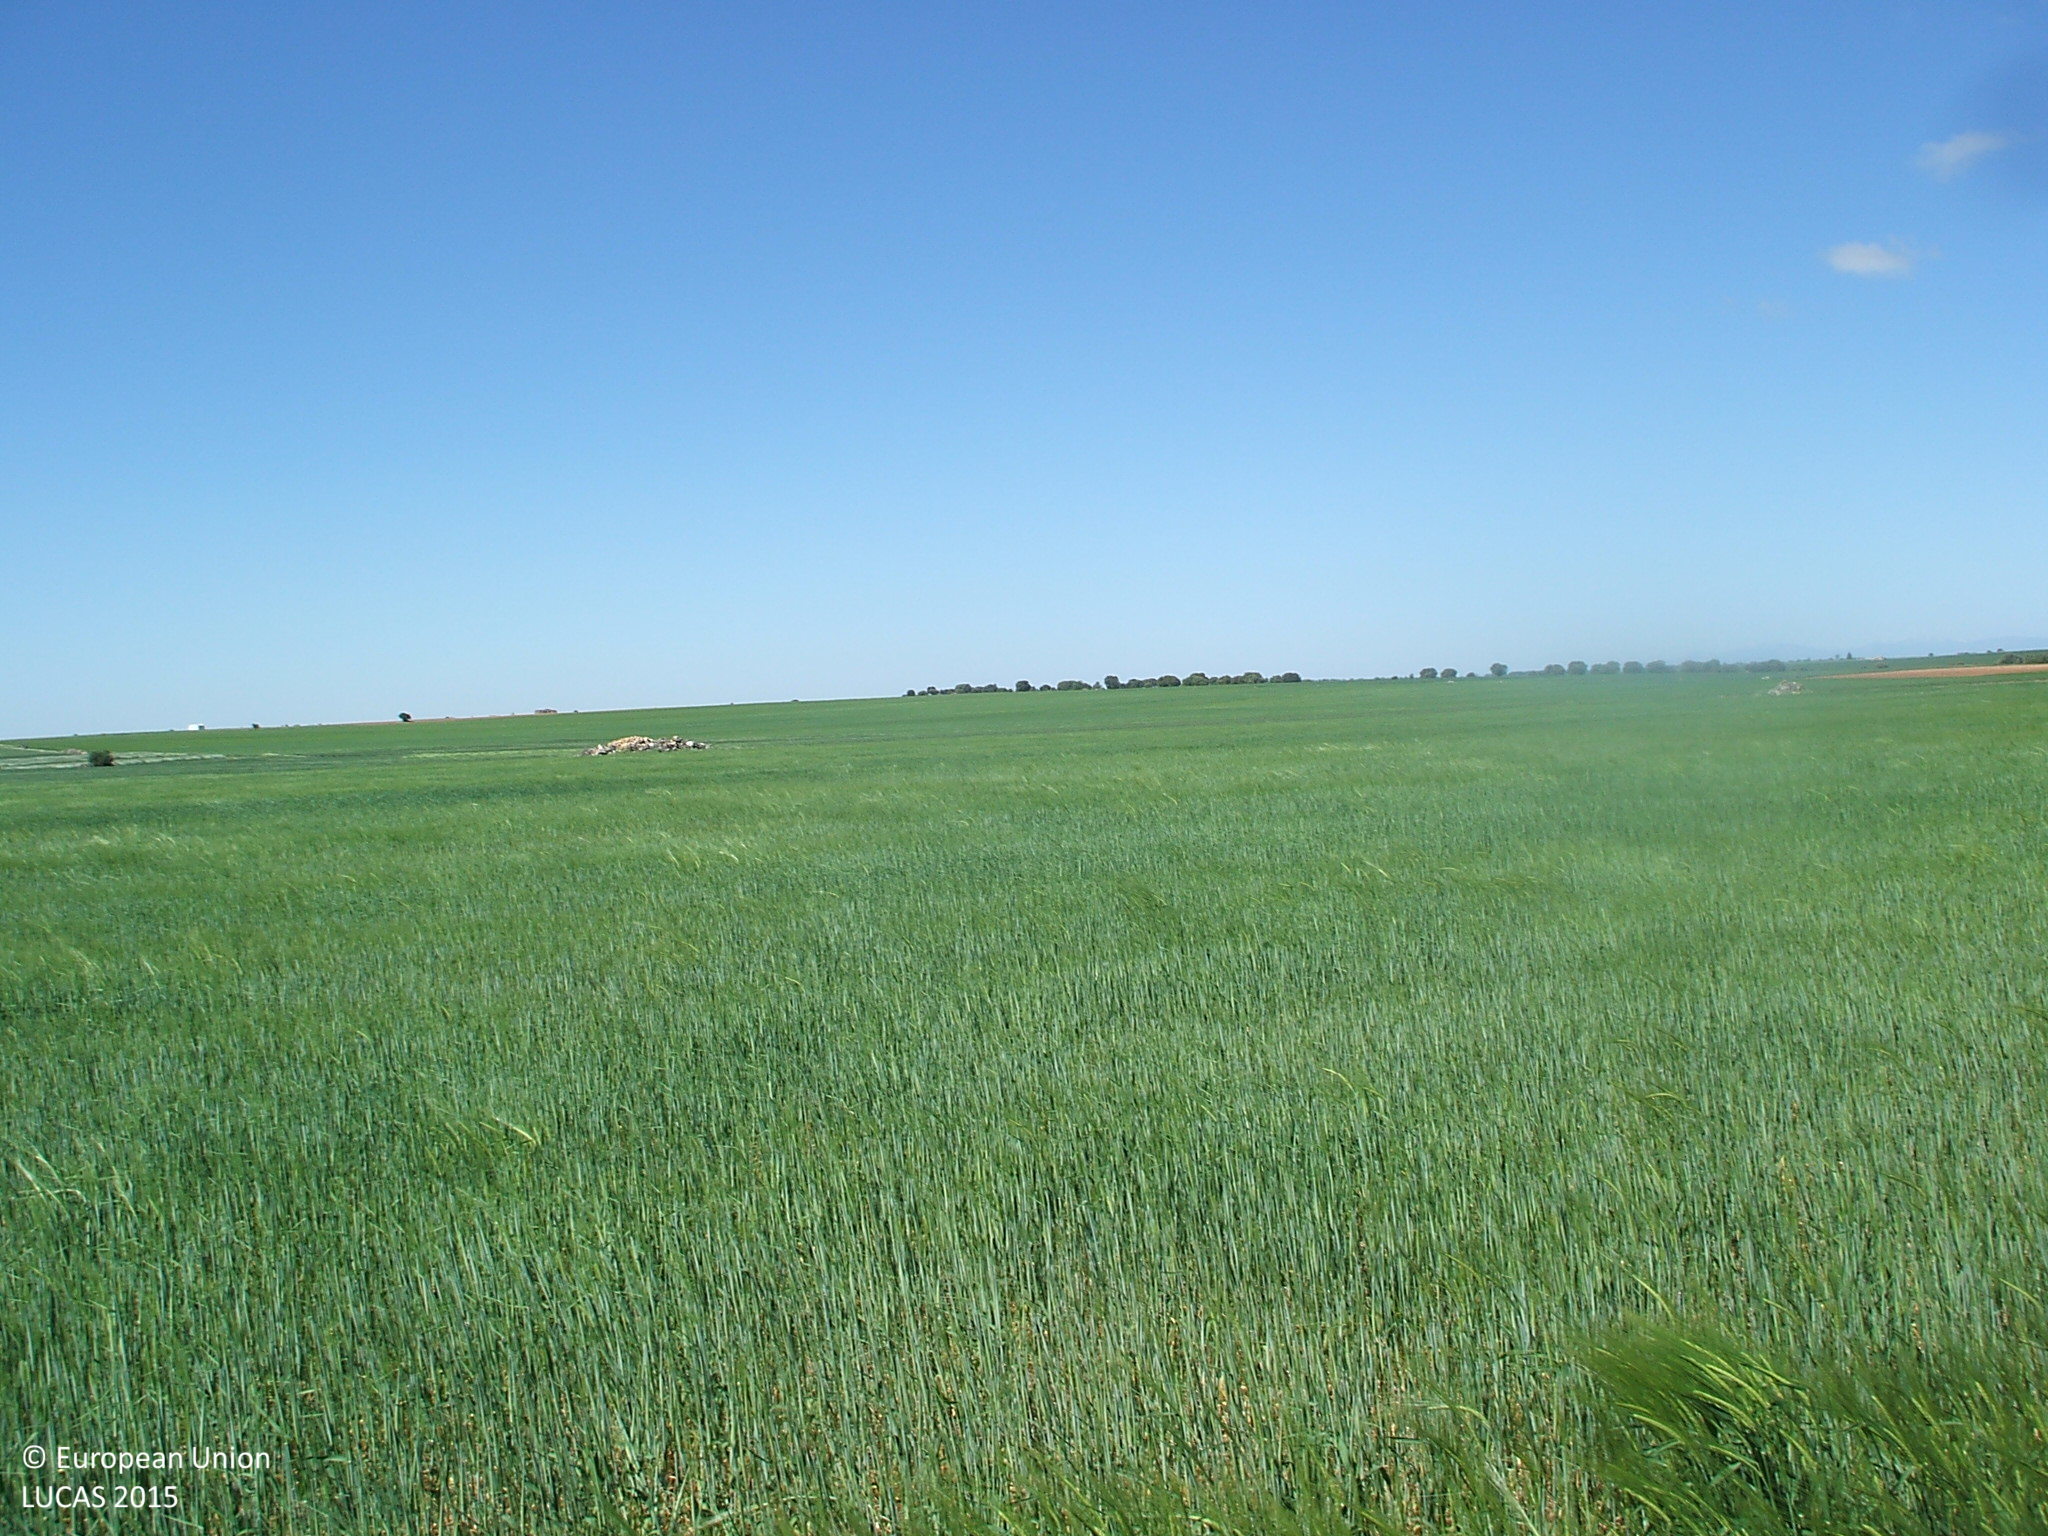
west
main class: Cropland
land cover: Barley
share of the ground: > 75 %
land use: Agriculture (excluding fallow land and kitchen gardens)
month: May
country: ES
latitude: 40.8980
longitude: -2.8647
